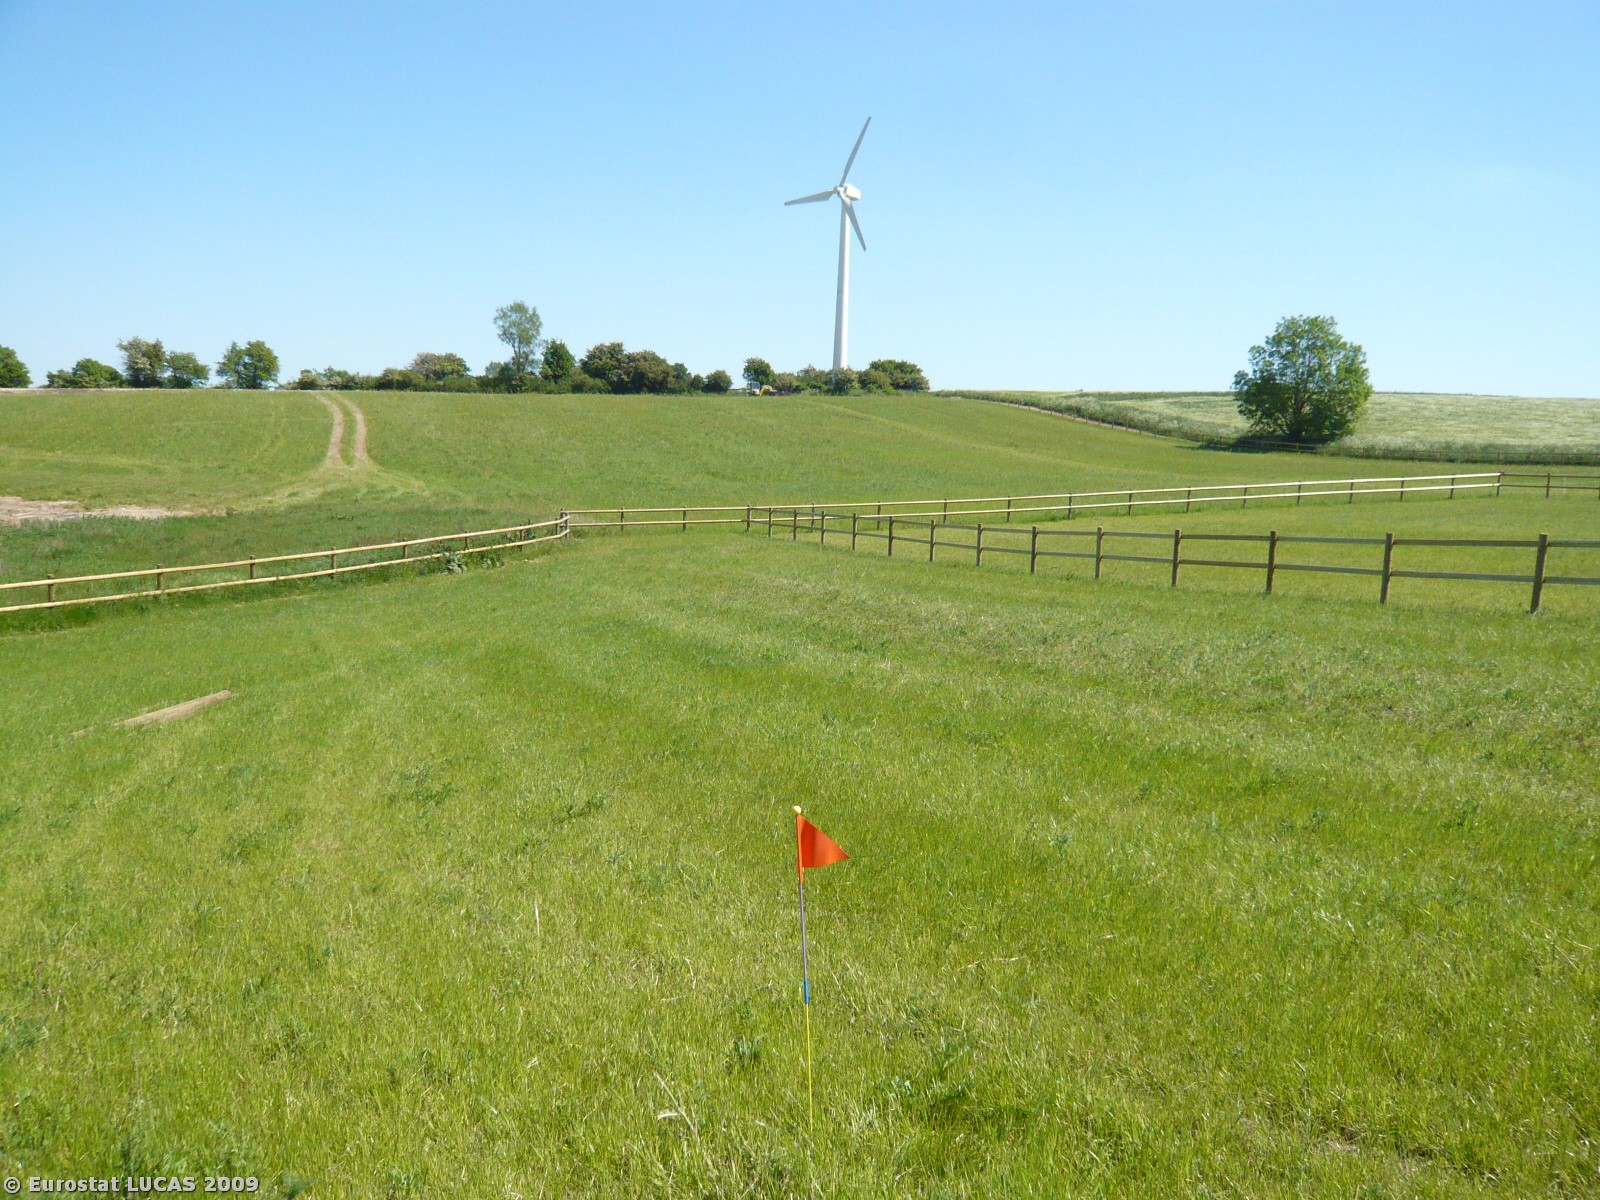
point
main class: Grassland
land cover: Grassland without tree/shrub cover
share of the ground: > 75 %
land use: Agriculture (excluding fallow land and kitchen gardens)
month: June
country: DK
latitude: 55.6505
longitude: 12.0165
